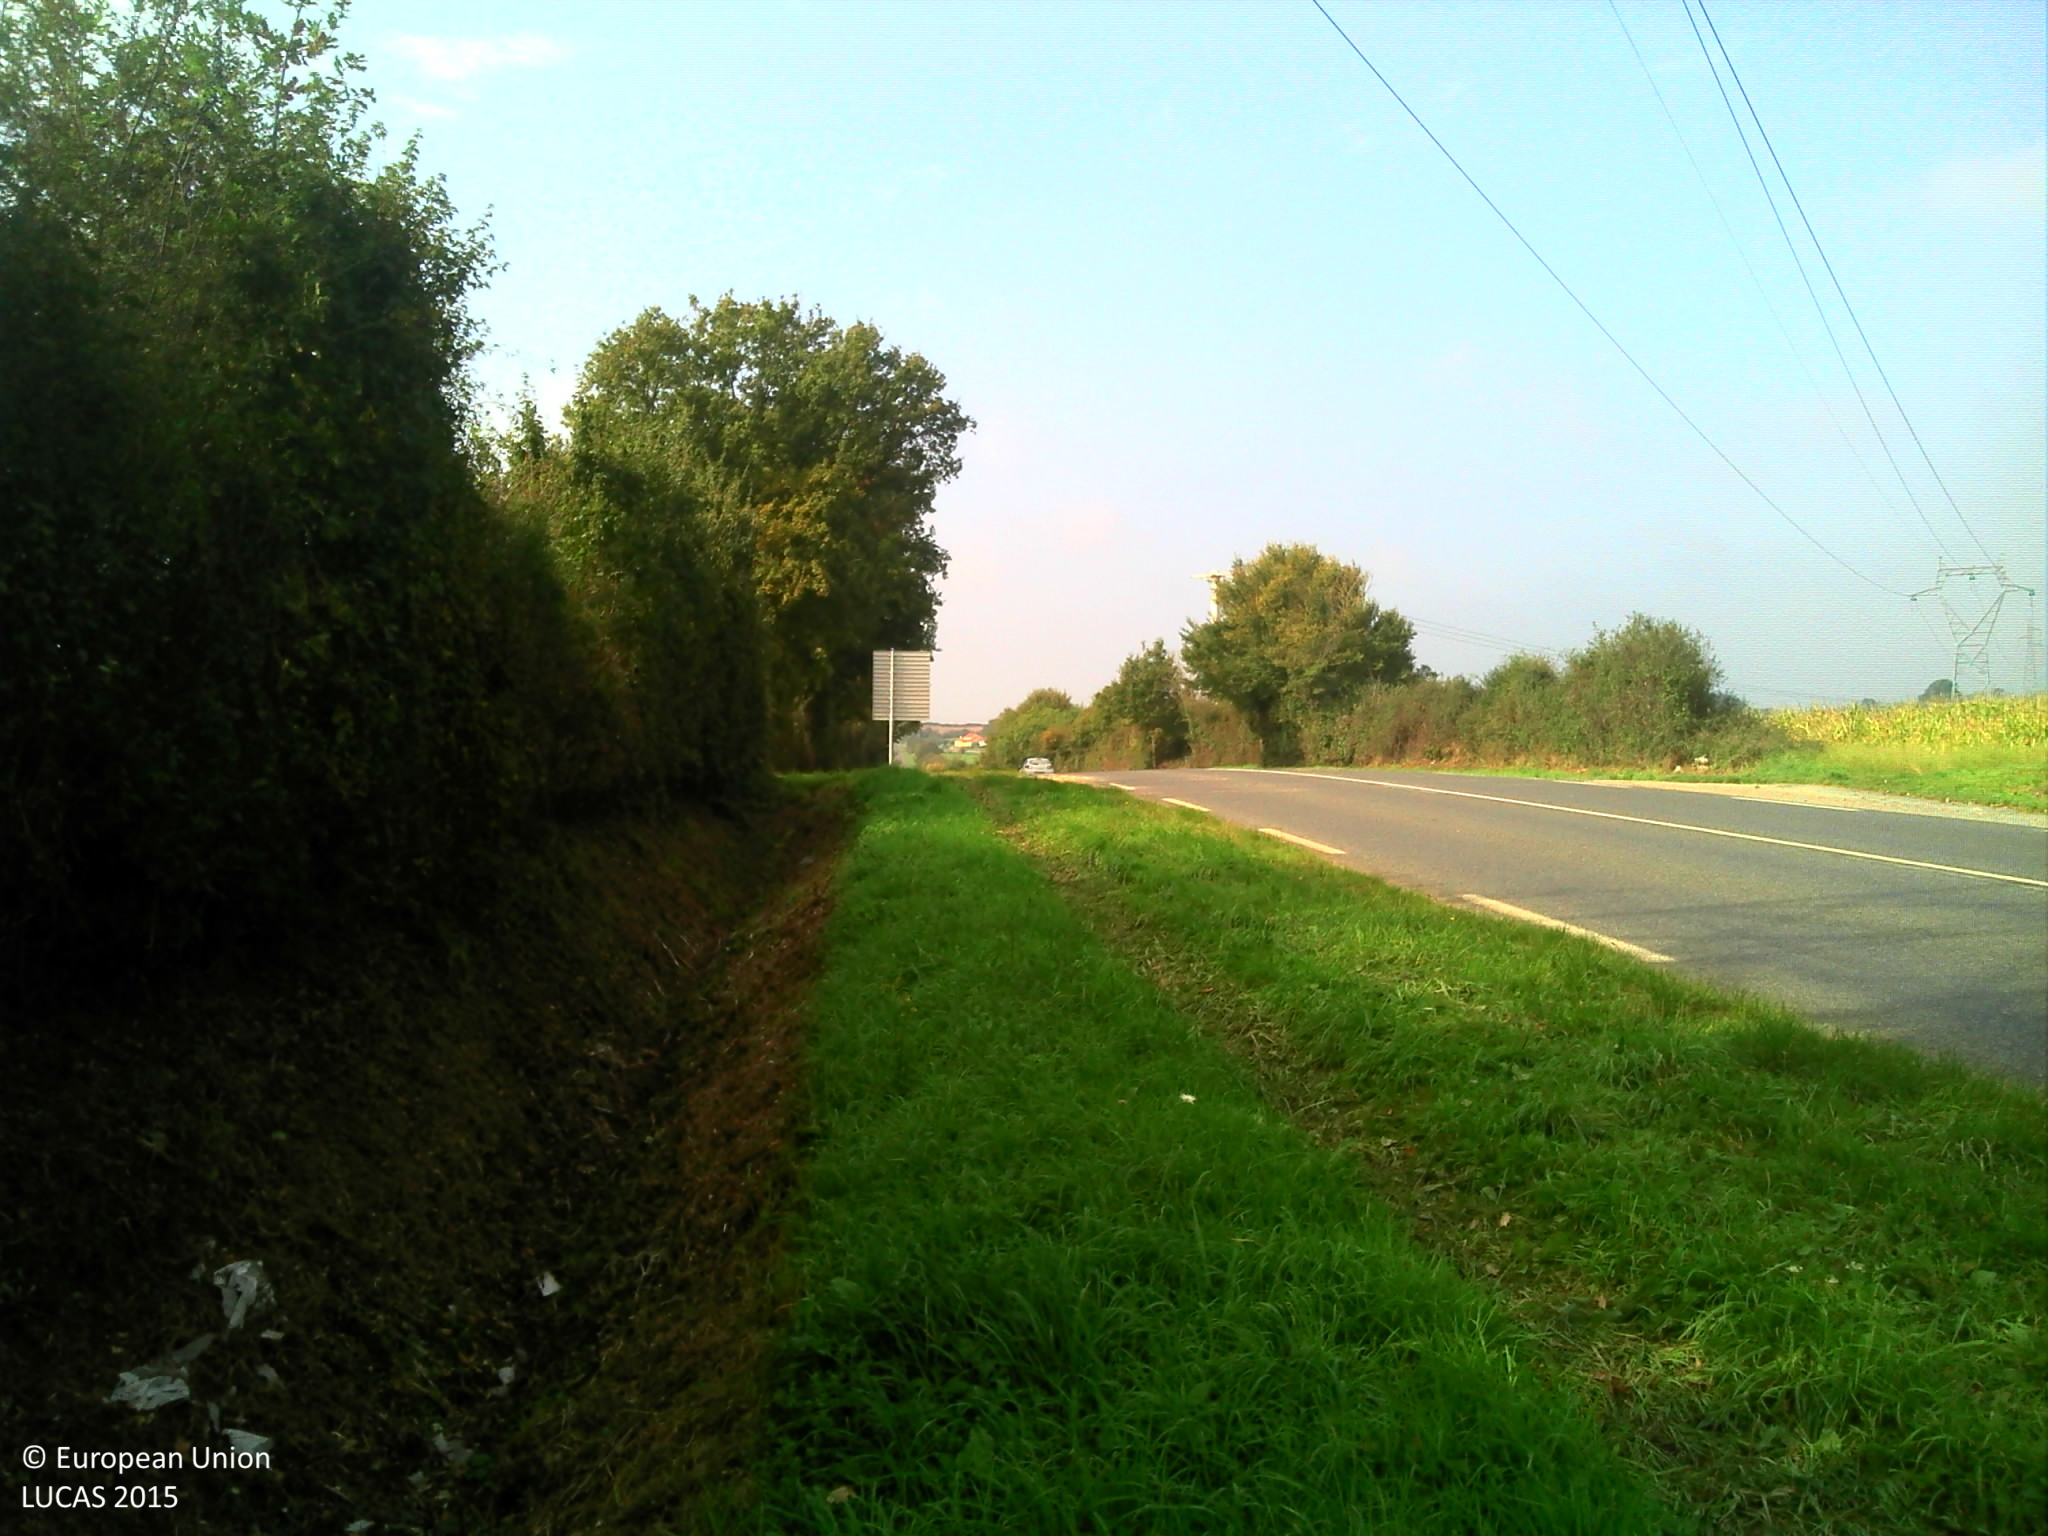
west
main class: Grassland
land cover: Grassland without tree/shrub cover
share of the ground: > 75 %
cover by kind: herbaceous plants 100 %
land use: Road transport
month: October
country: FR
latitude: 47.0591
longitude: -0.9483
